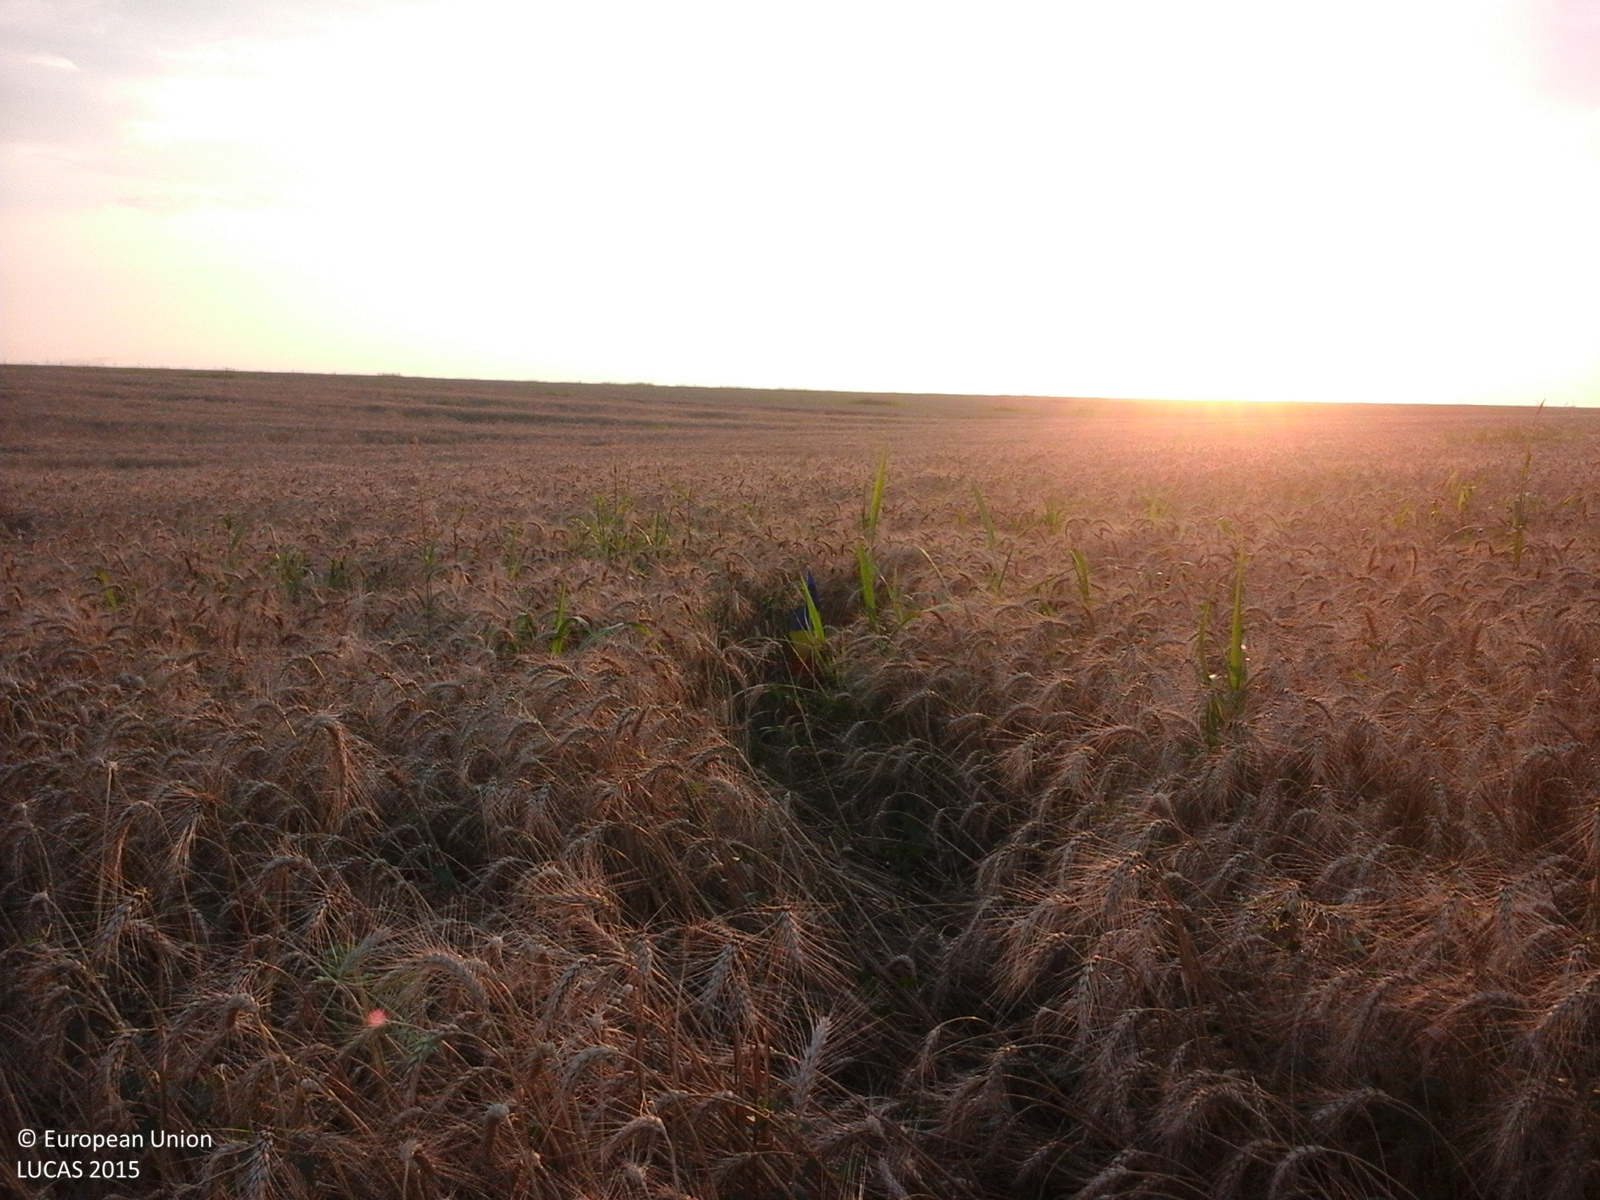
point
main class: Cropland
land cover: Common wheat
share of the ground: > 75 %
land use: Agriculture (excluding fallow land and kitchen gardens)
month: July
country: RO
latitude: 43.8838
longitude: 25.5580
